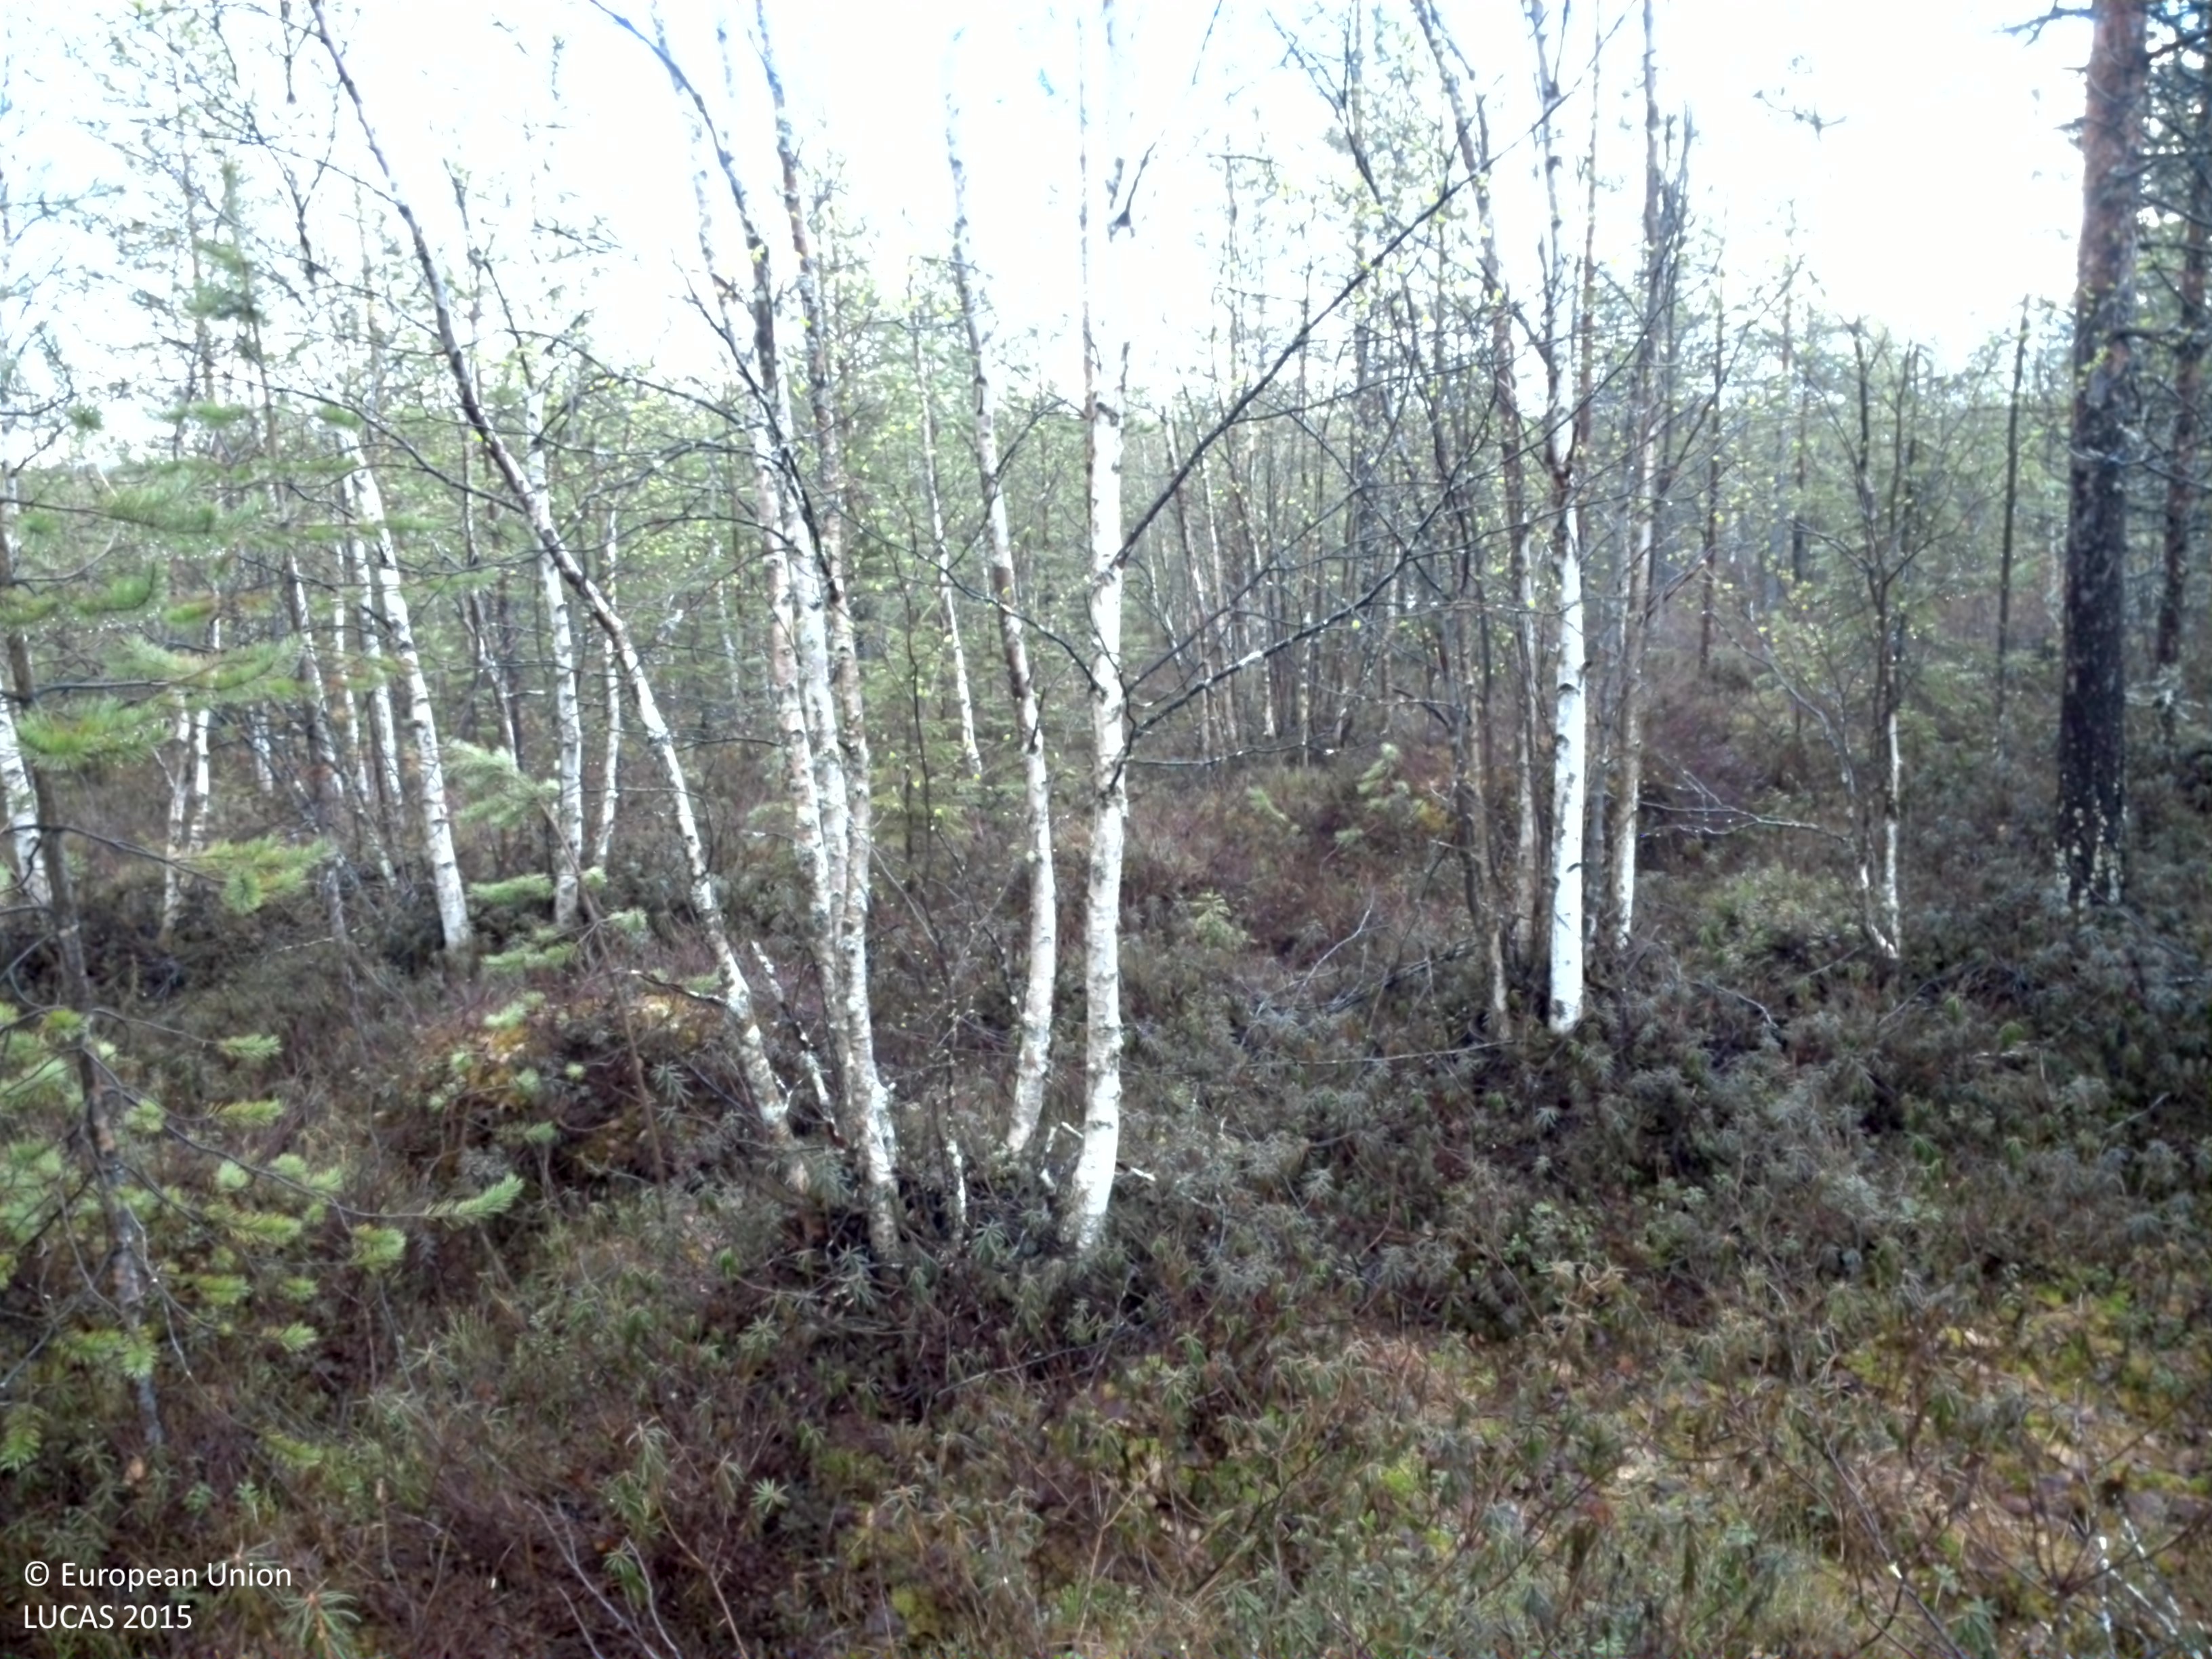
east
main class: Woodland
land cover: Pine dominated mixed woodland
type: boreal forest
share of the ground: 50 - 75 %
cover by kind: shrubs 40 %, coniferous forest trees 25 %, broadleaved forest trees 25 %, lichens and mosses 10 %
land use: Forestry
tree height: > 5 m
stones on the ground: 25 - 50 %
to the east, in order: Pine dominated mixed woodland; Pine dominated coniferous woodland; Pine dominated mixed woodland
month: May
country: SE
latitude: 66.2185
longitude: 23.1619
